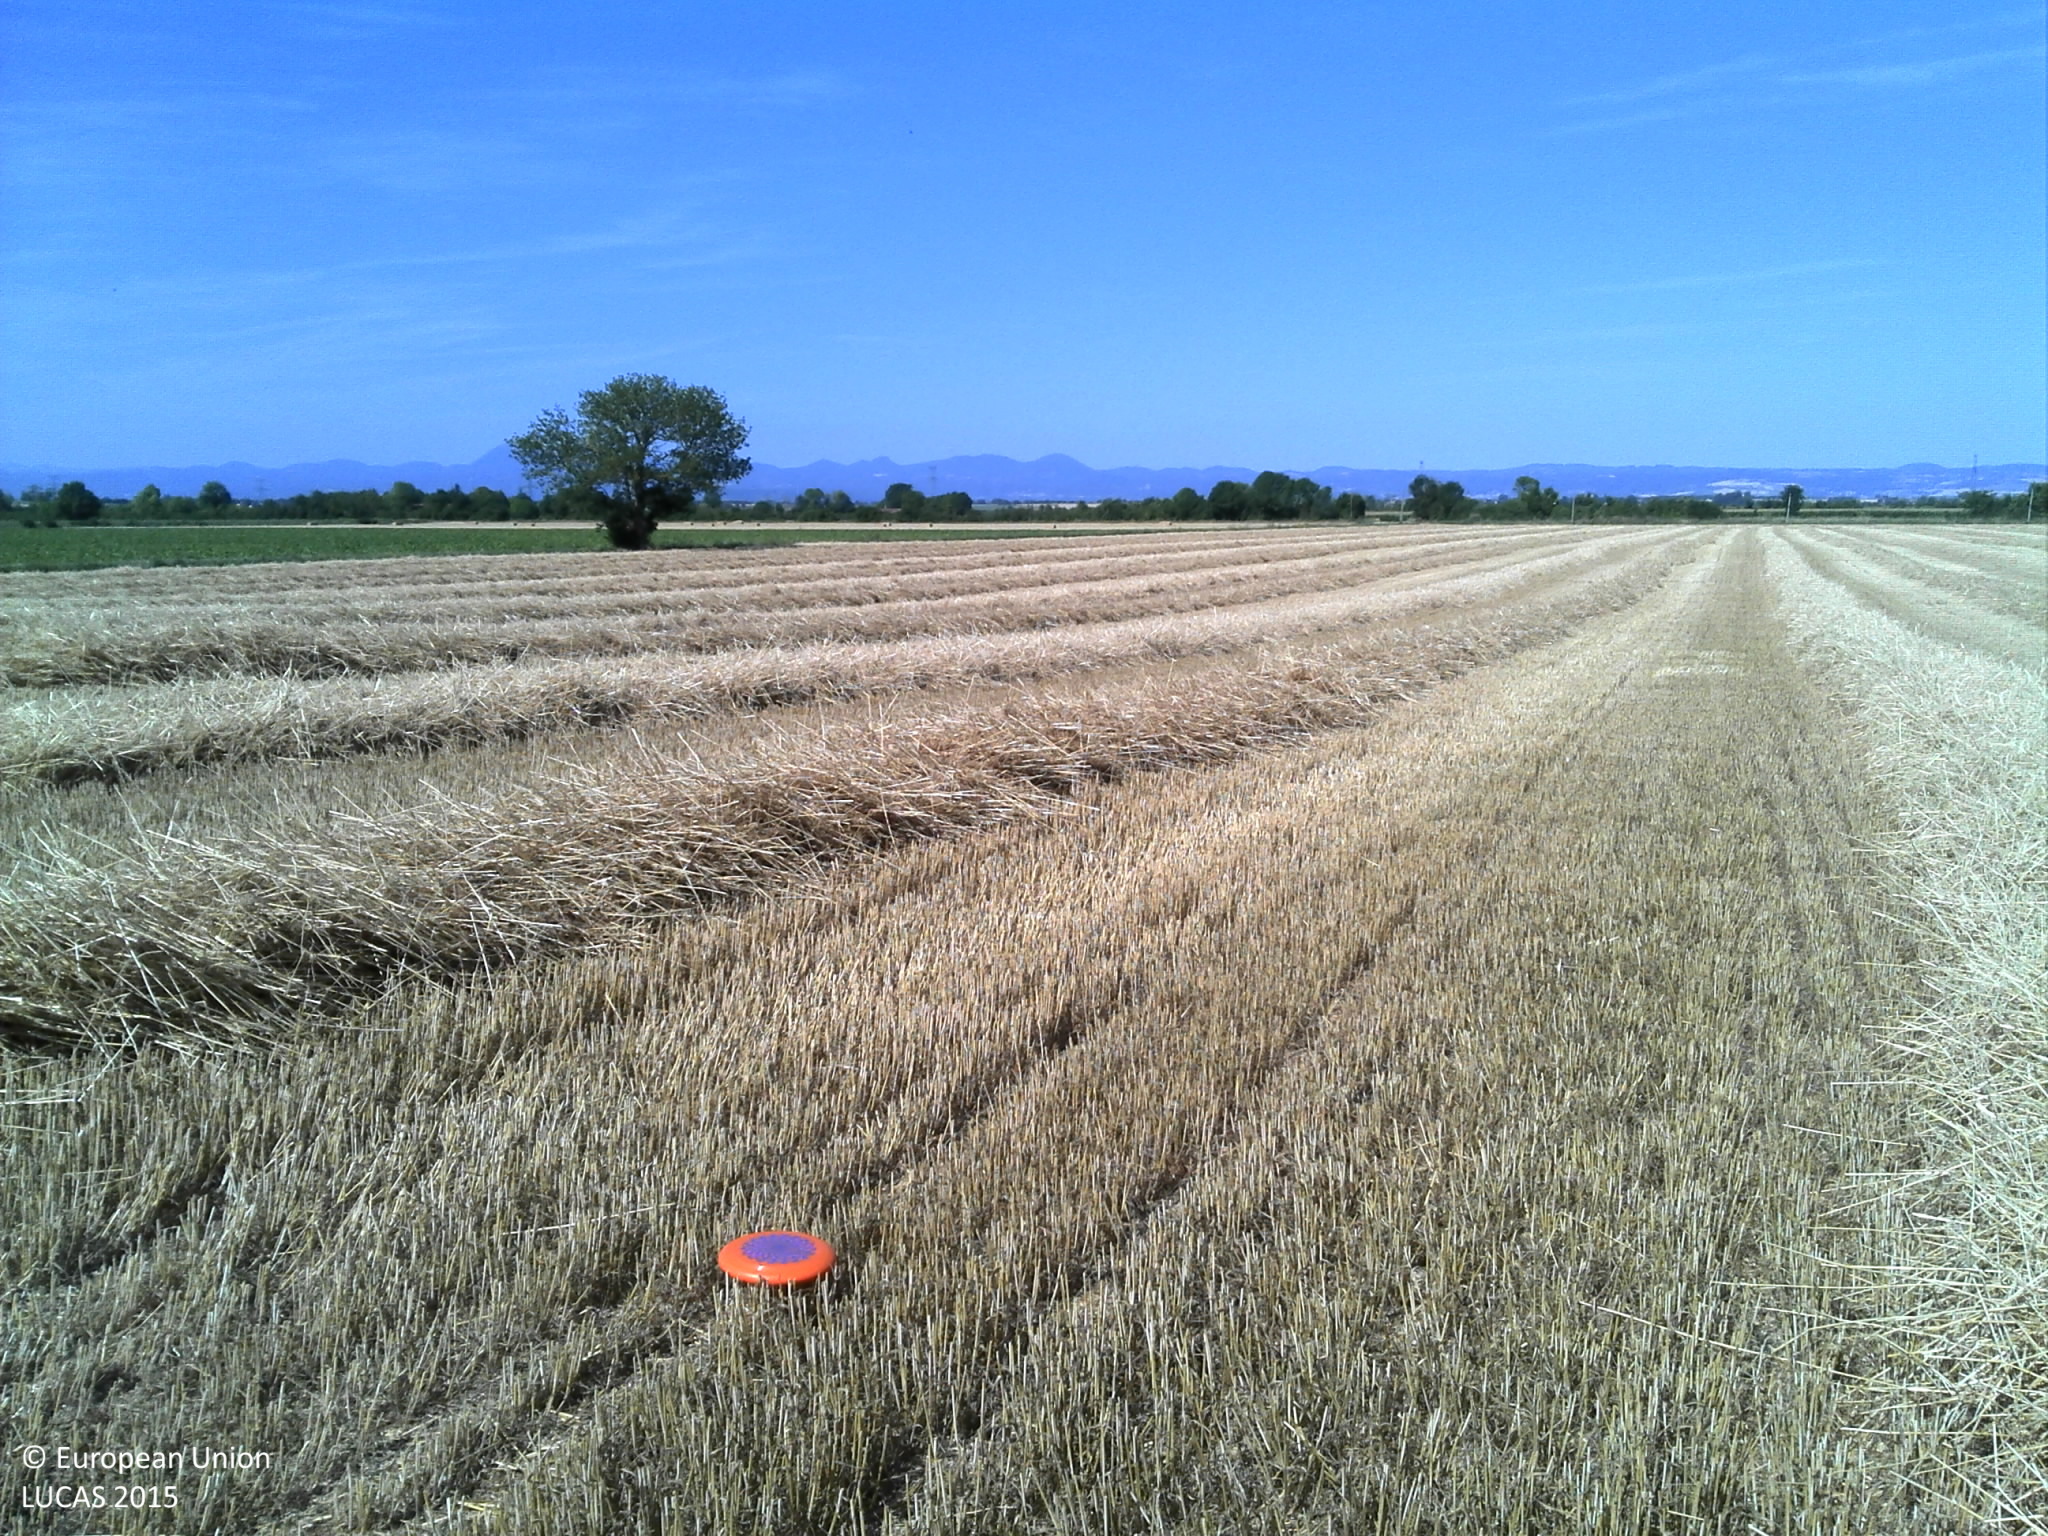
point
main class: Cropland
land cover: Common wheat
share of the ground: > 75 %
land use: Agriculture (excluding fallow land and kitchen gardens)
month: July
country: FR
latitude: 45.9426
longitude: 3.3052
